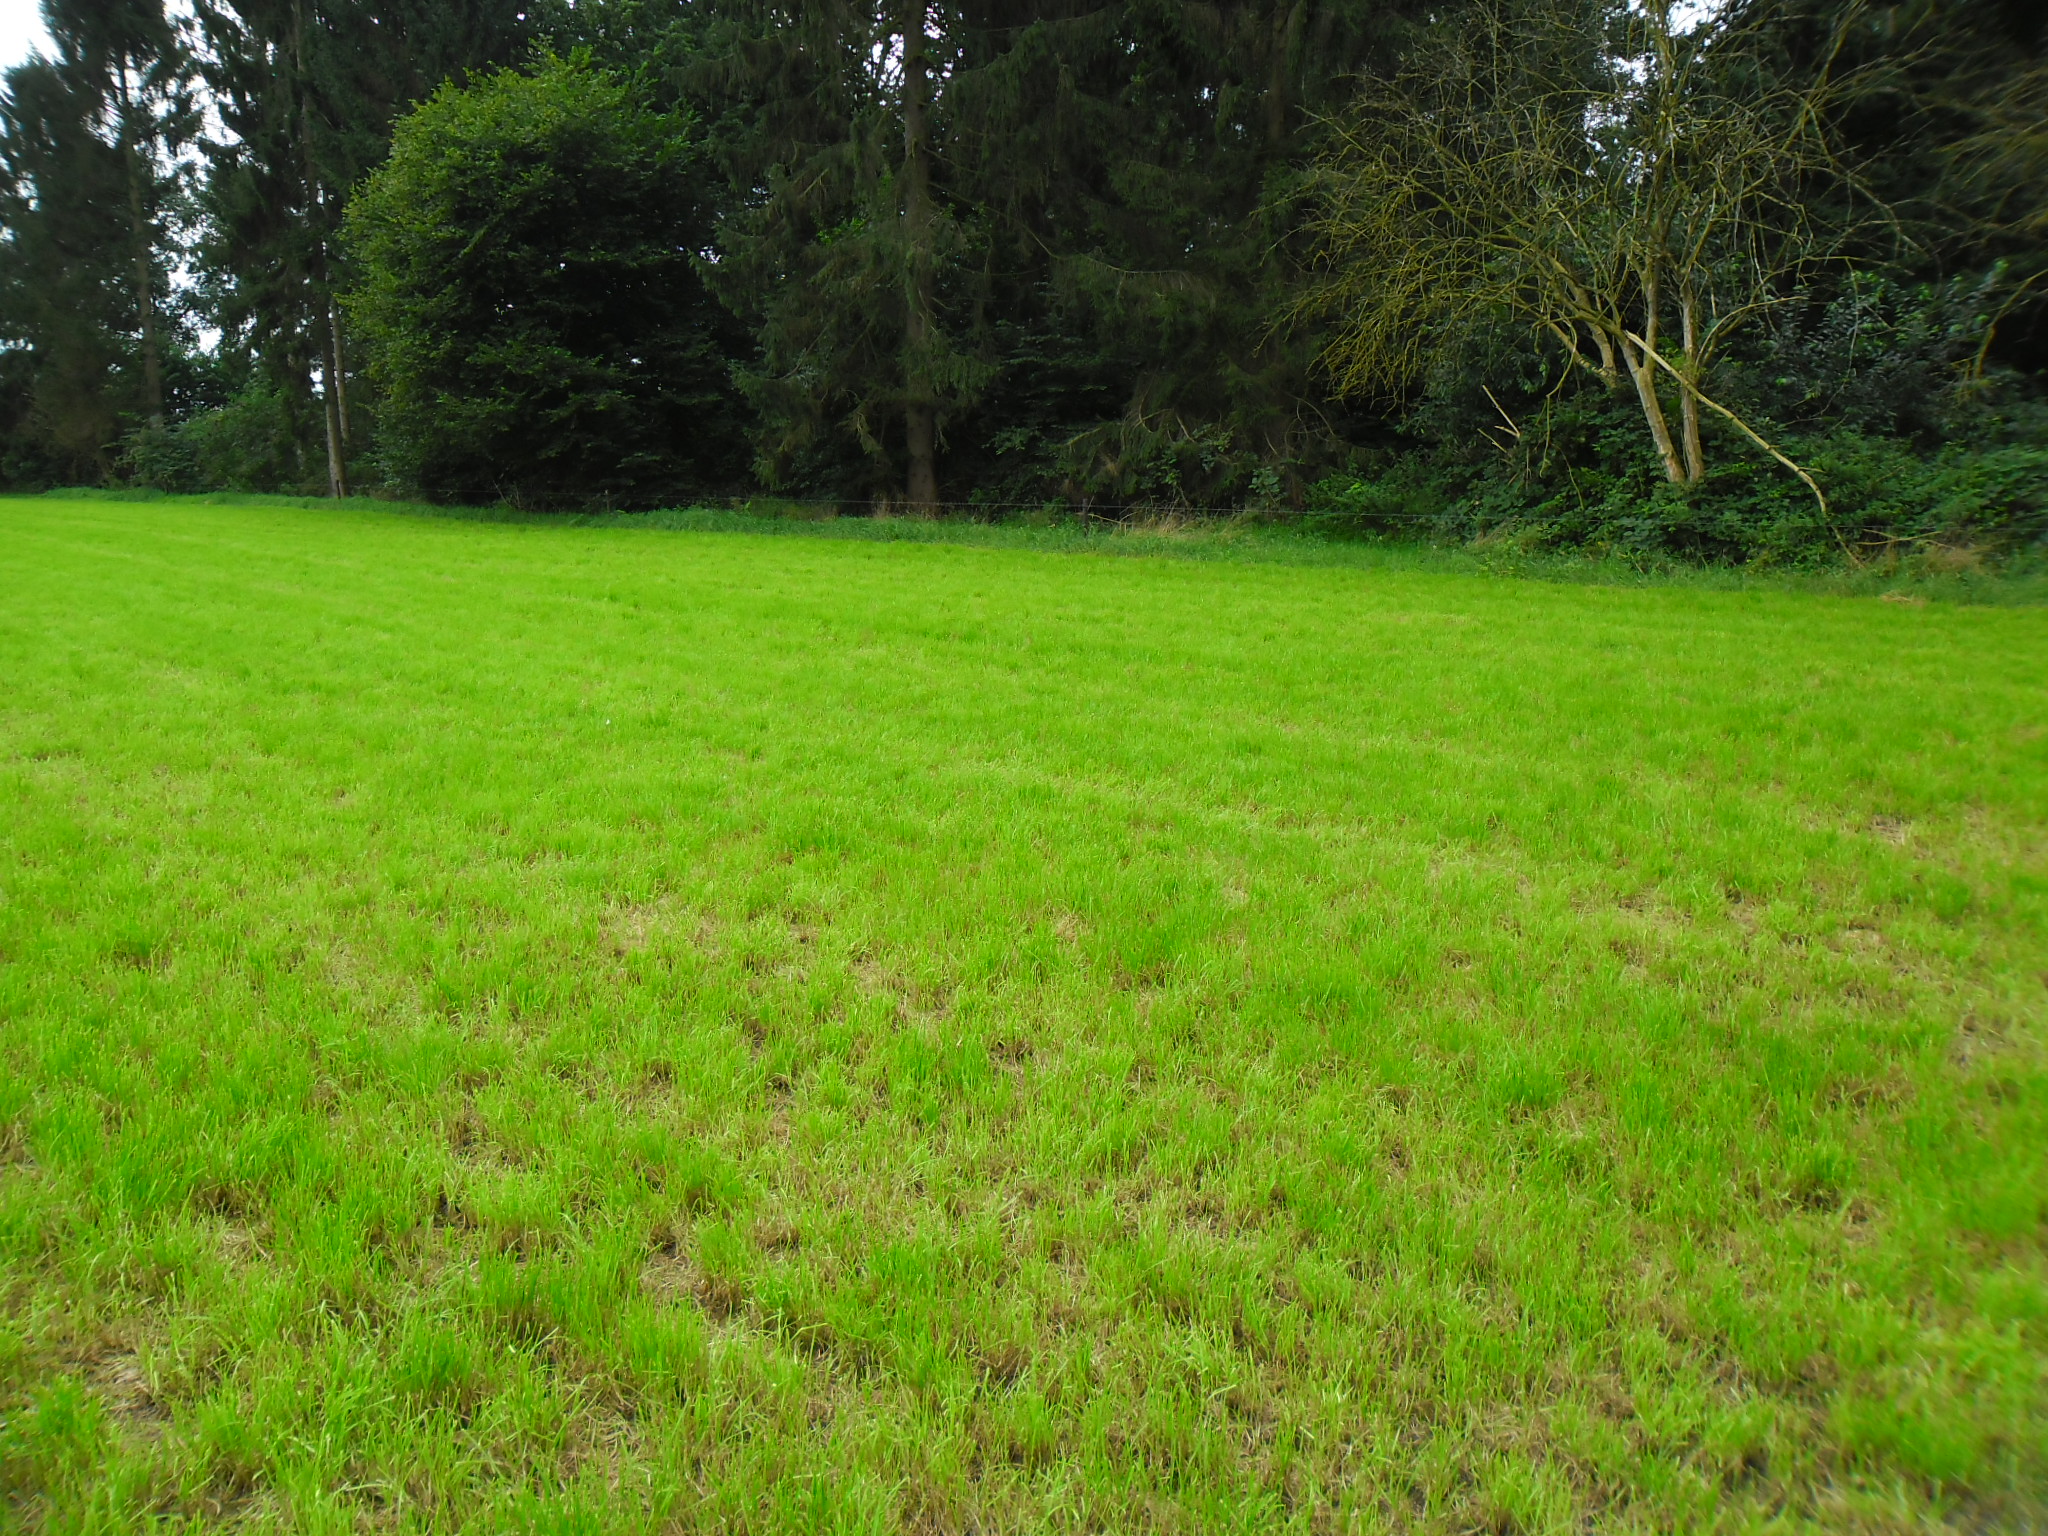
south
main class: Grassland
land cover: Grassland without tree/shrub cover
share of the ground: > 75 %
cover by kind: herbaceous plants 100 %
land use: Agriculture (excluding fallow land and kitchen gardens)
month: September
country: NL
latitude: 52.1570
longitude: 6.2721
